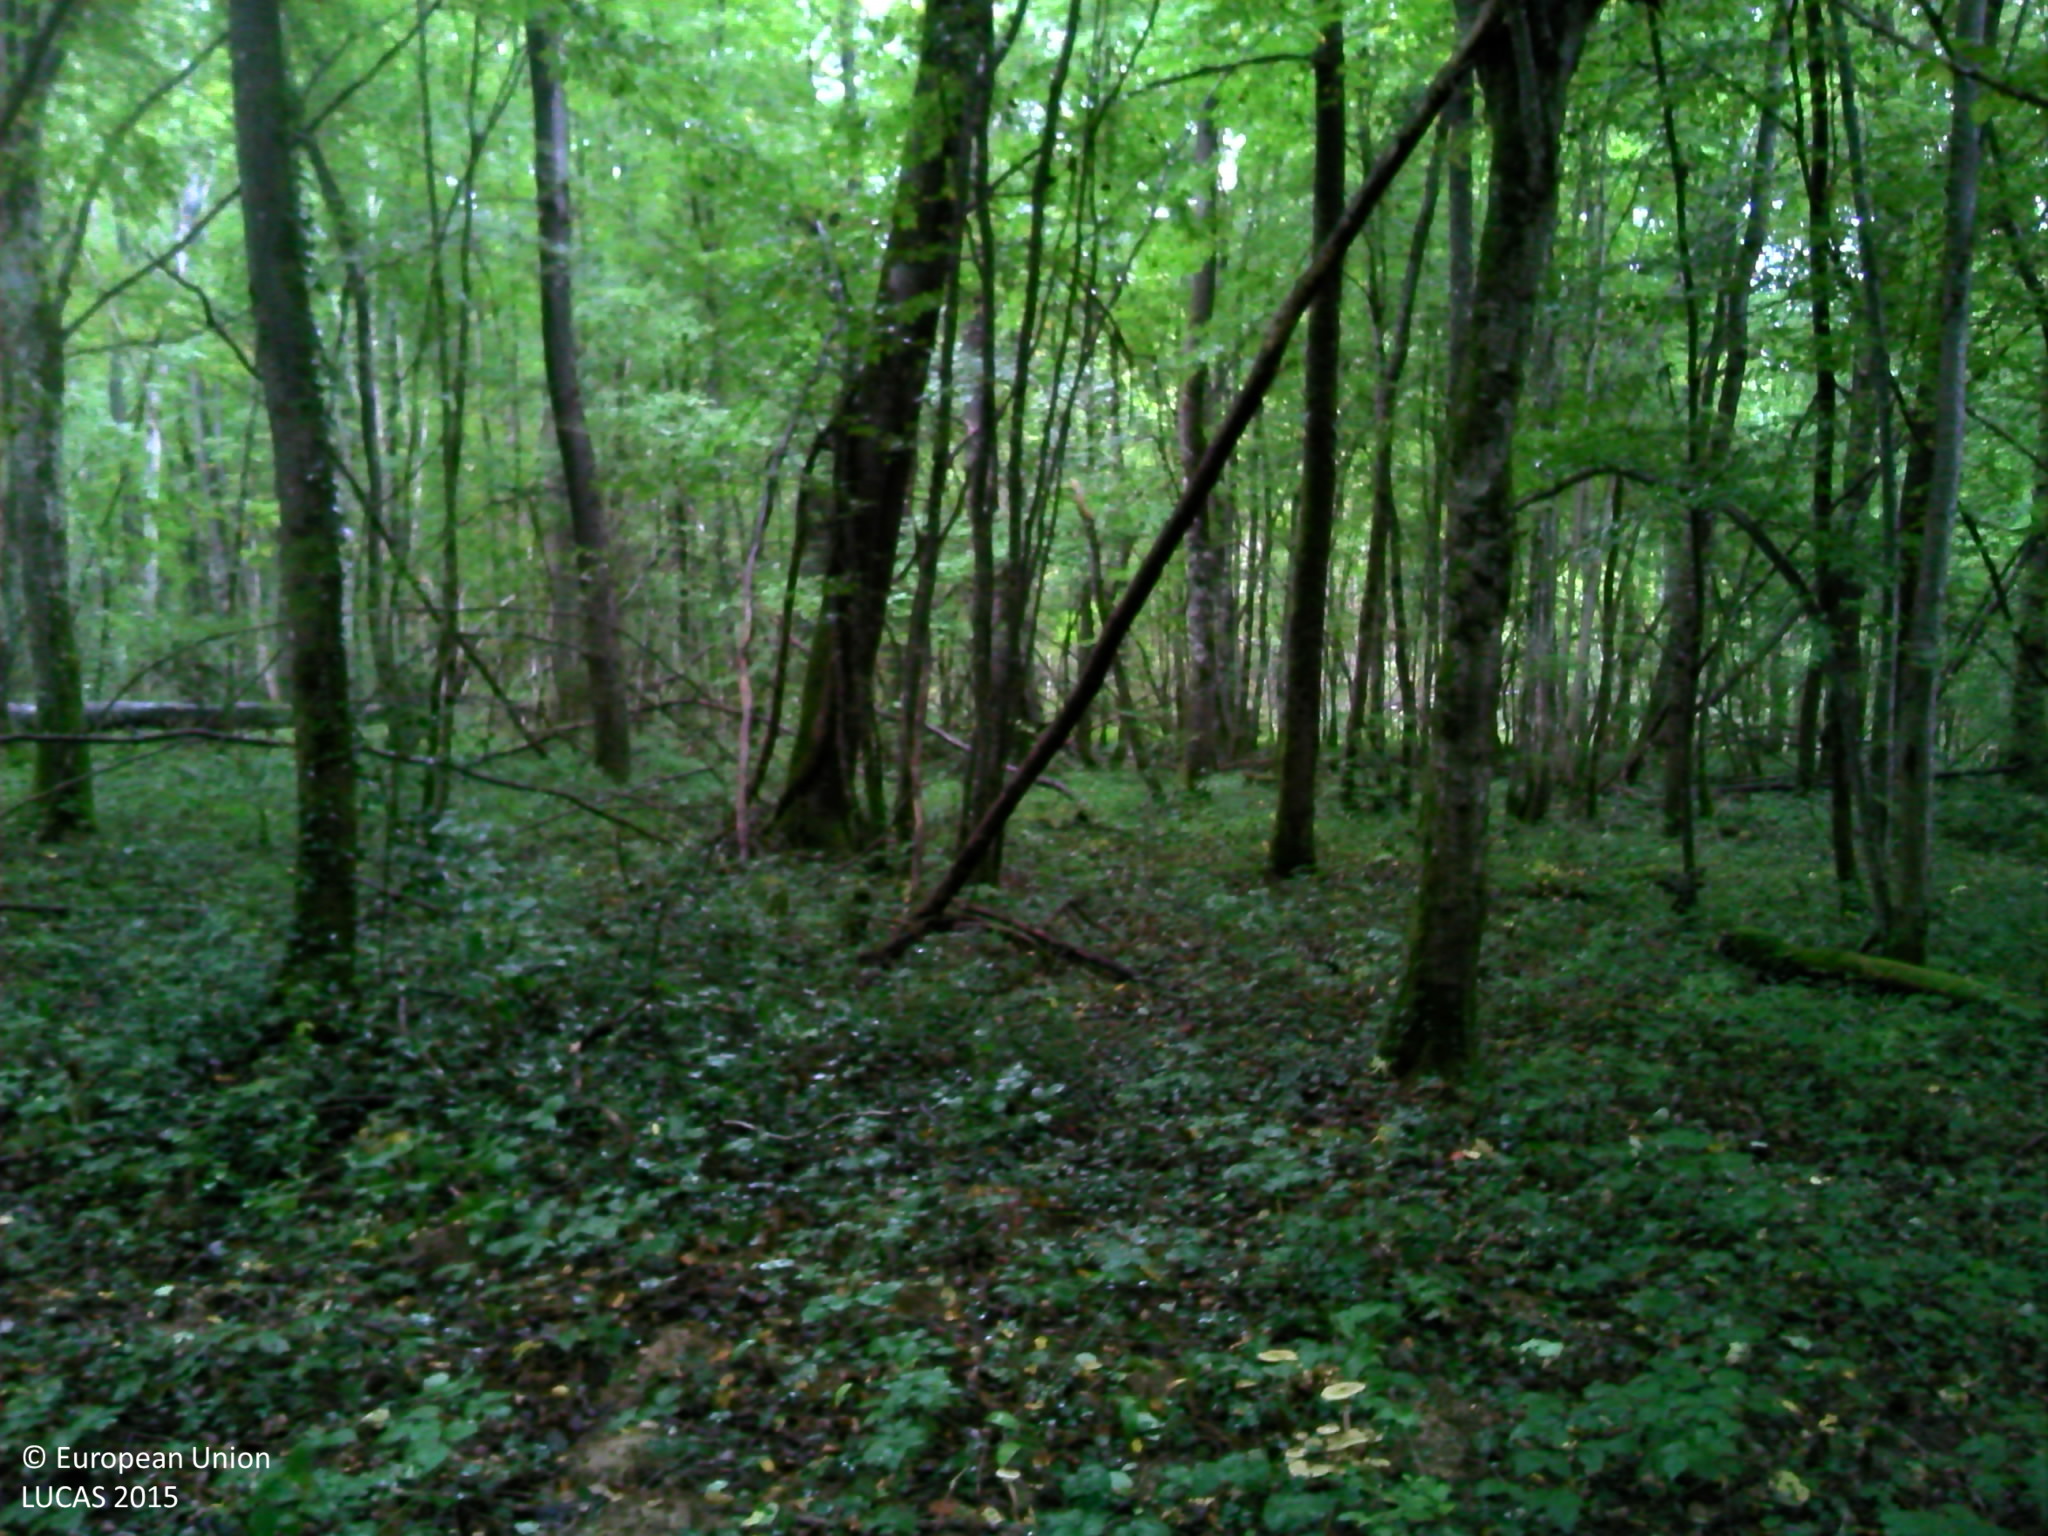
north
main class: Woodland
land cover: Broadleaved woodland
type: acidophilous oak and oak-birch forest
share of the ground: > 75 %
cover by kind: broadleaved forest trees 95 %, herbaceous plants 5 %
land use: Forestry
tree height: > 5 m
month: September
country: FR
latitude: 47.0671
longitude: 5.0632
